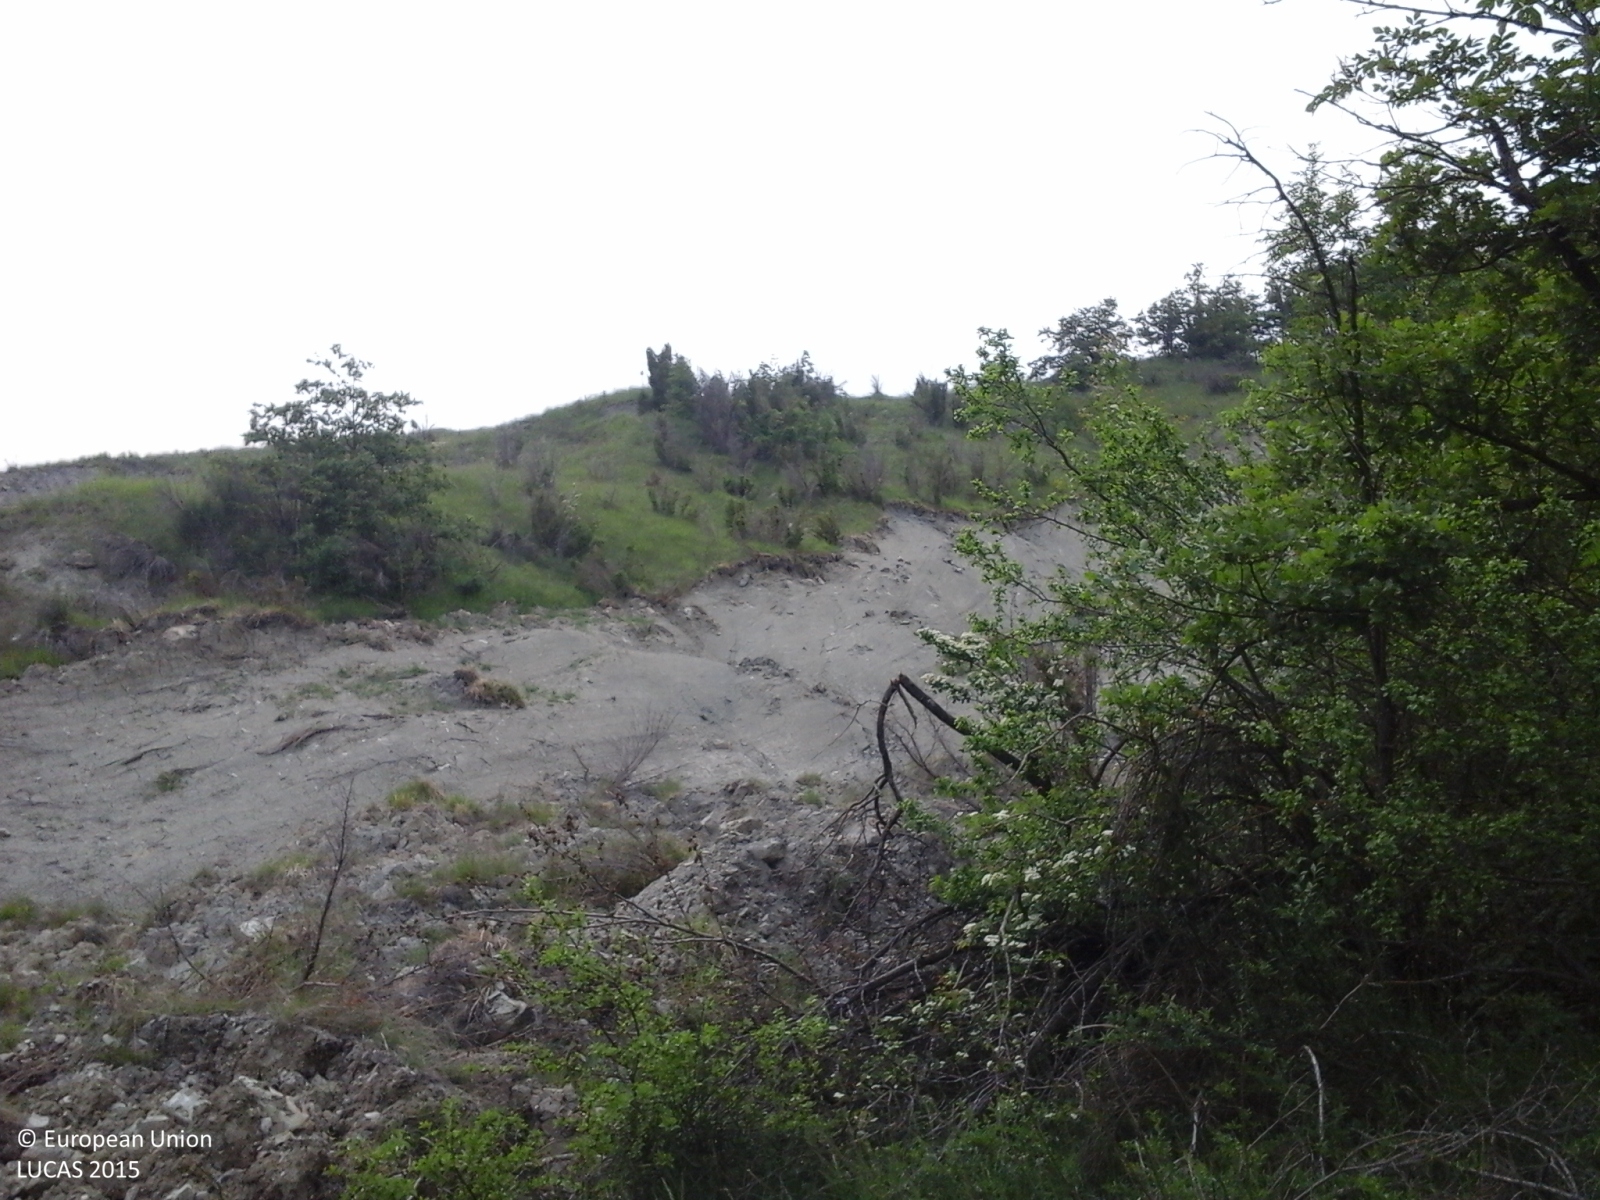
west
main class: Woodland
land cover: Broadleaved woodland
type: mesophytic deciduous forest
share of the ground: 50 - 75 %
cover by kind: broadleaved forest trees 65 %, herbaceous plants 20 %, shrubs 10 %, unconsolidated bare surface 5 %
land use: Semi-natural and natural areas not in use
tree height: > 5 m
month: May
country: IT
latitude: 44.4189
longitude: 10.8897
